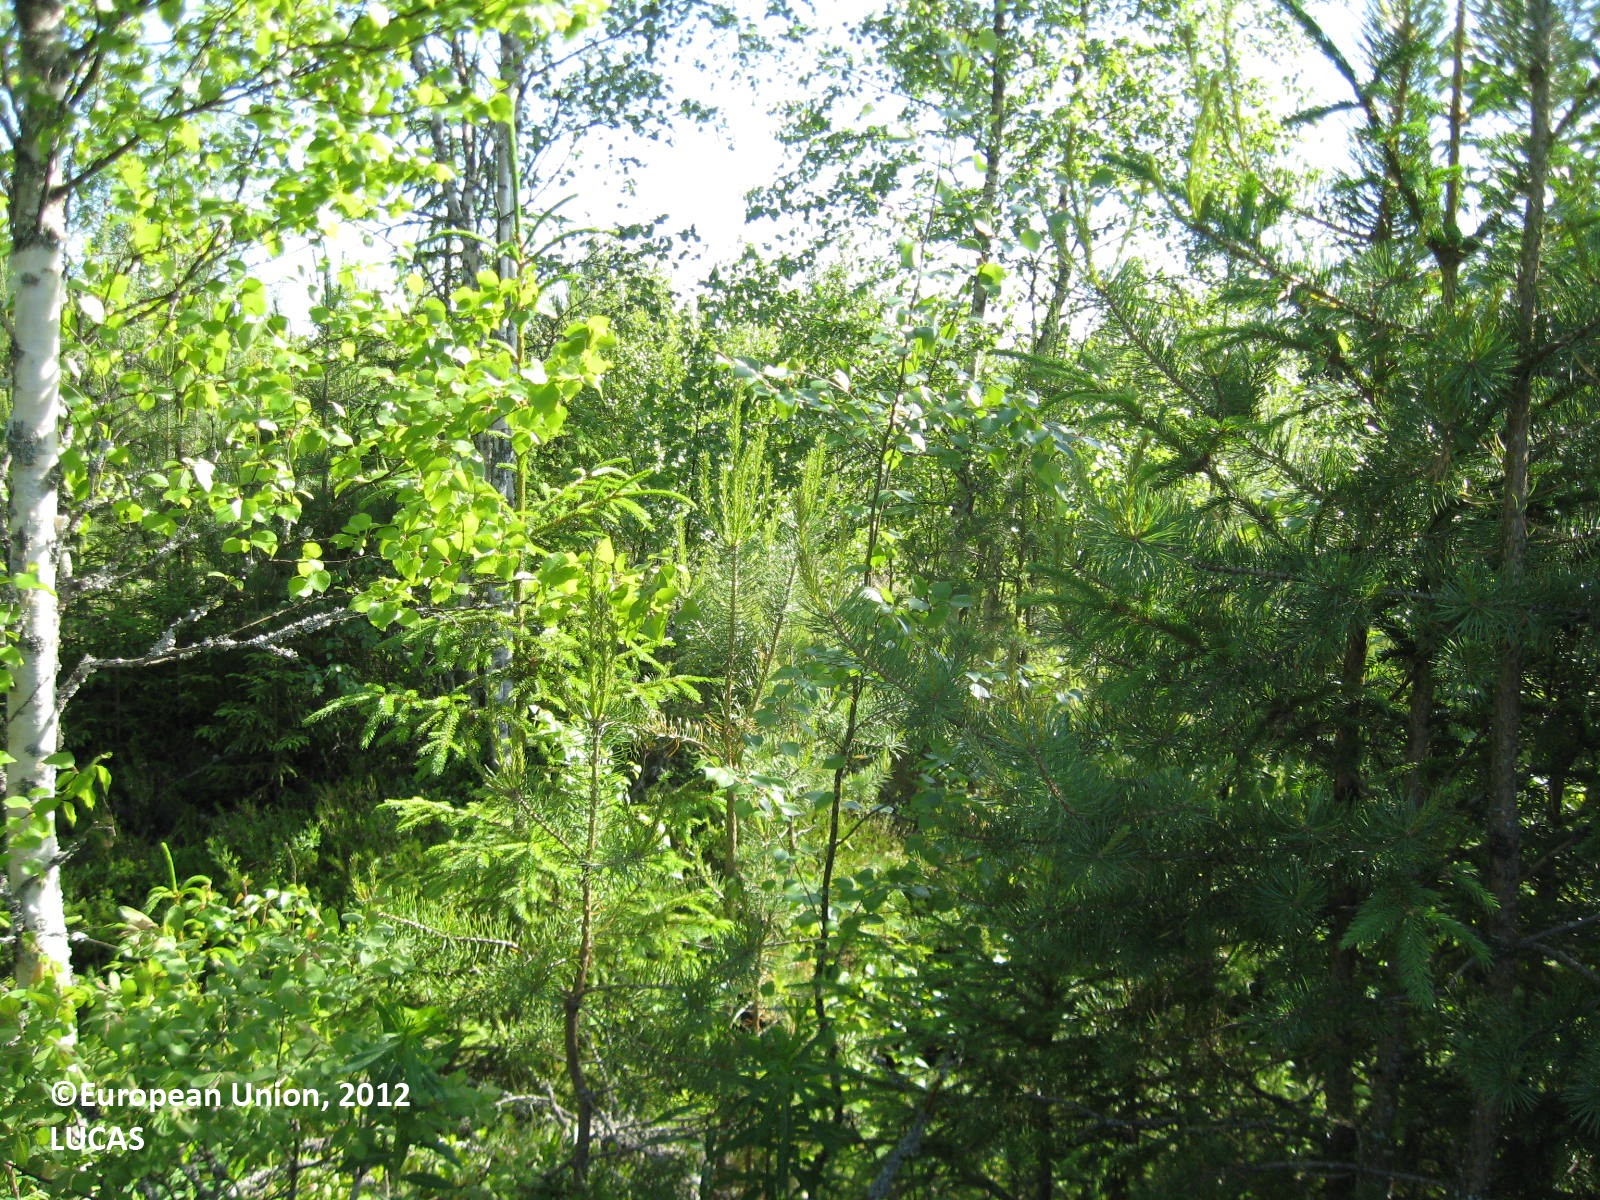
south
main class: Woodland
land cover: Other mixed woodland
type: boreal forest
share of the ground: > 75 %
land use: Forestry
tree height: < 5 m
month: June
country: FI
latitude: 62.6247
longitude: 21.7612
